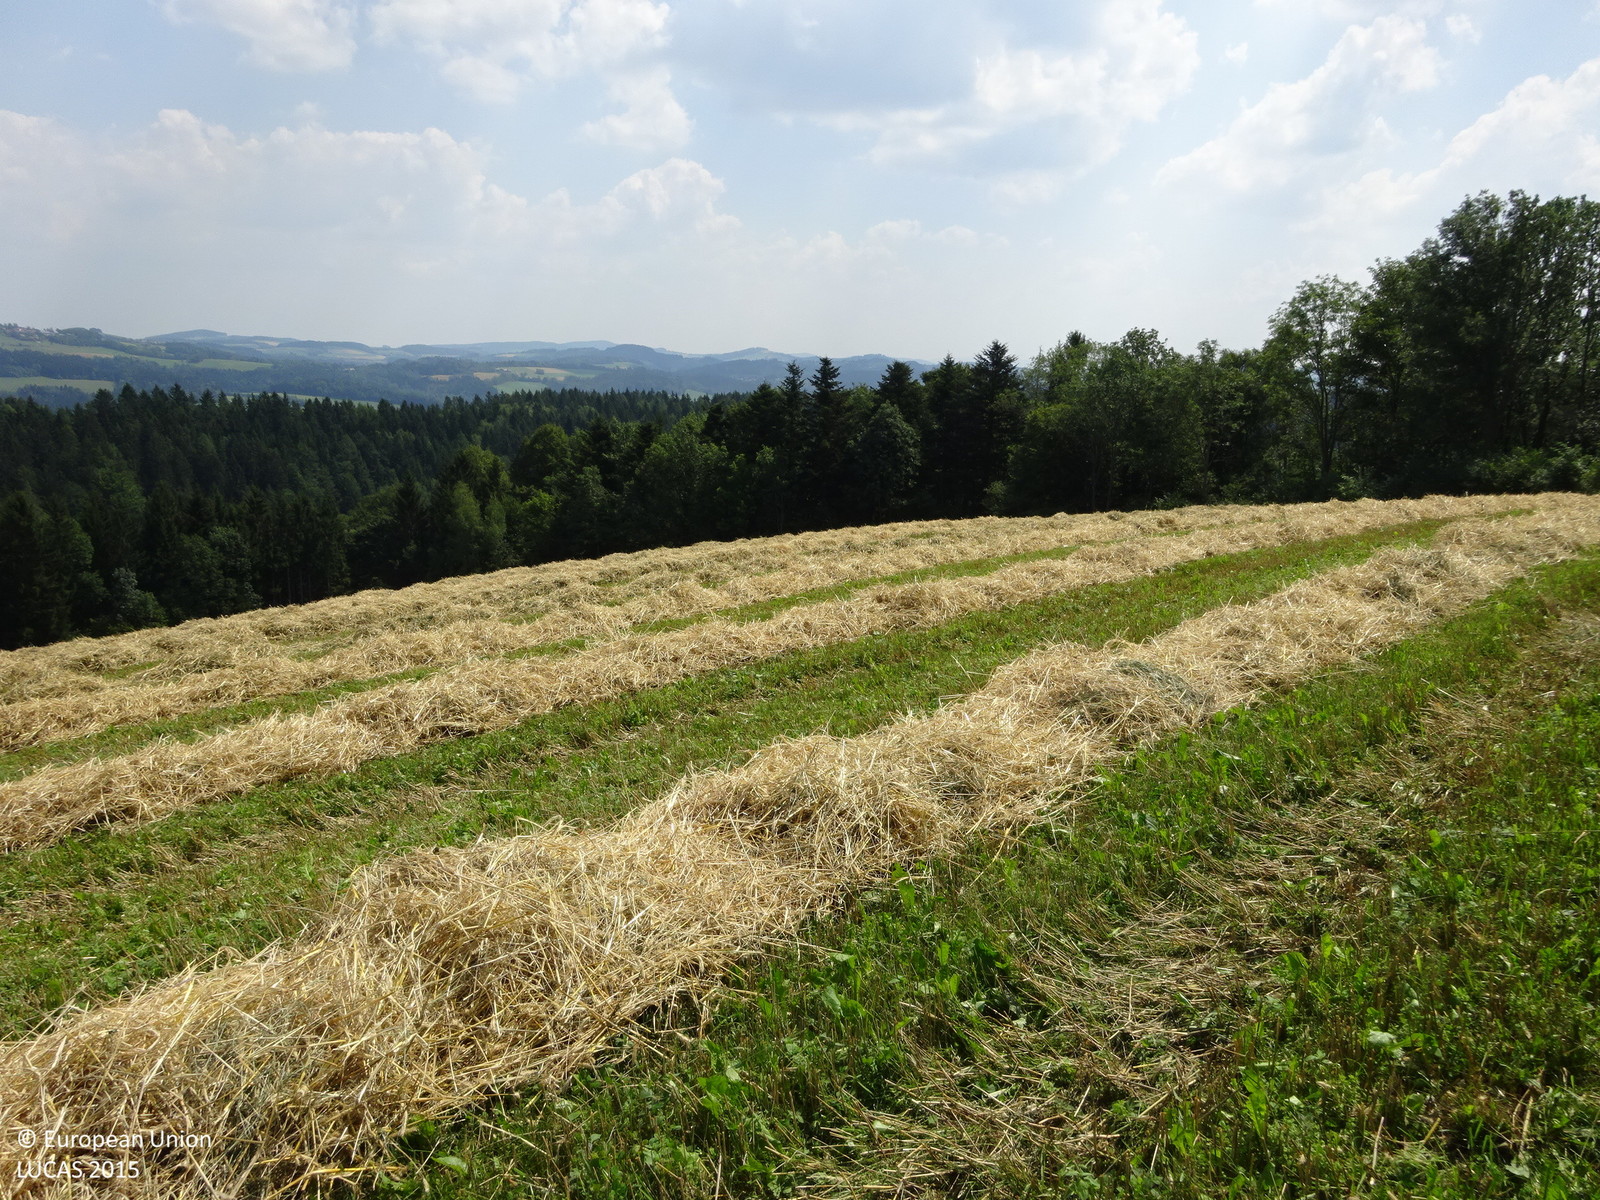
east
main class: Cropland
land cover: Maize
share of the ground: > 75 %
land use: Agriculture (excluding fallow land and kitchen gardens)
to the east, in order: Maize; Rye; Clovers; Spruce dominated mixed woodland; Rivers and streams; Spruce dominated mixed woodland
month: August
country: AT
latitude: 47.4804
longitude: 16.0403
